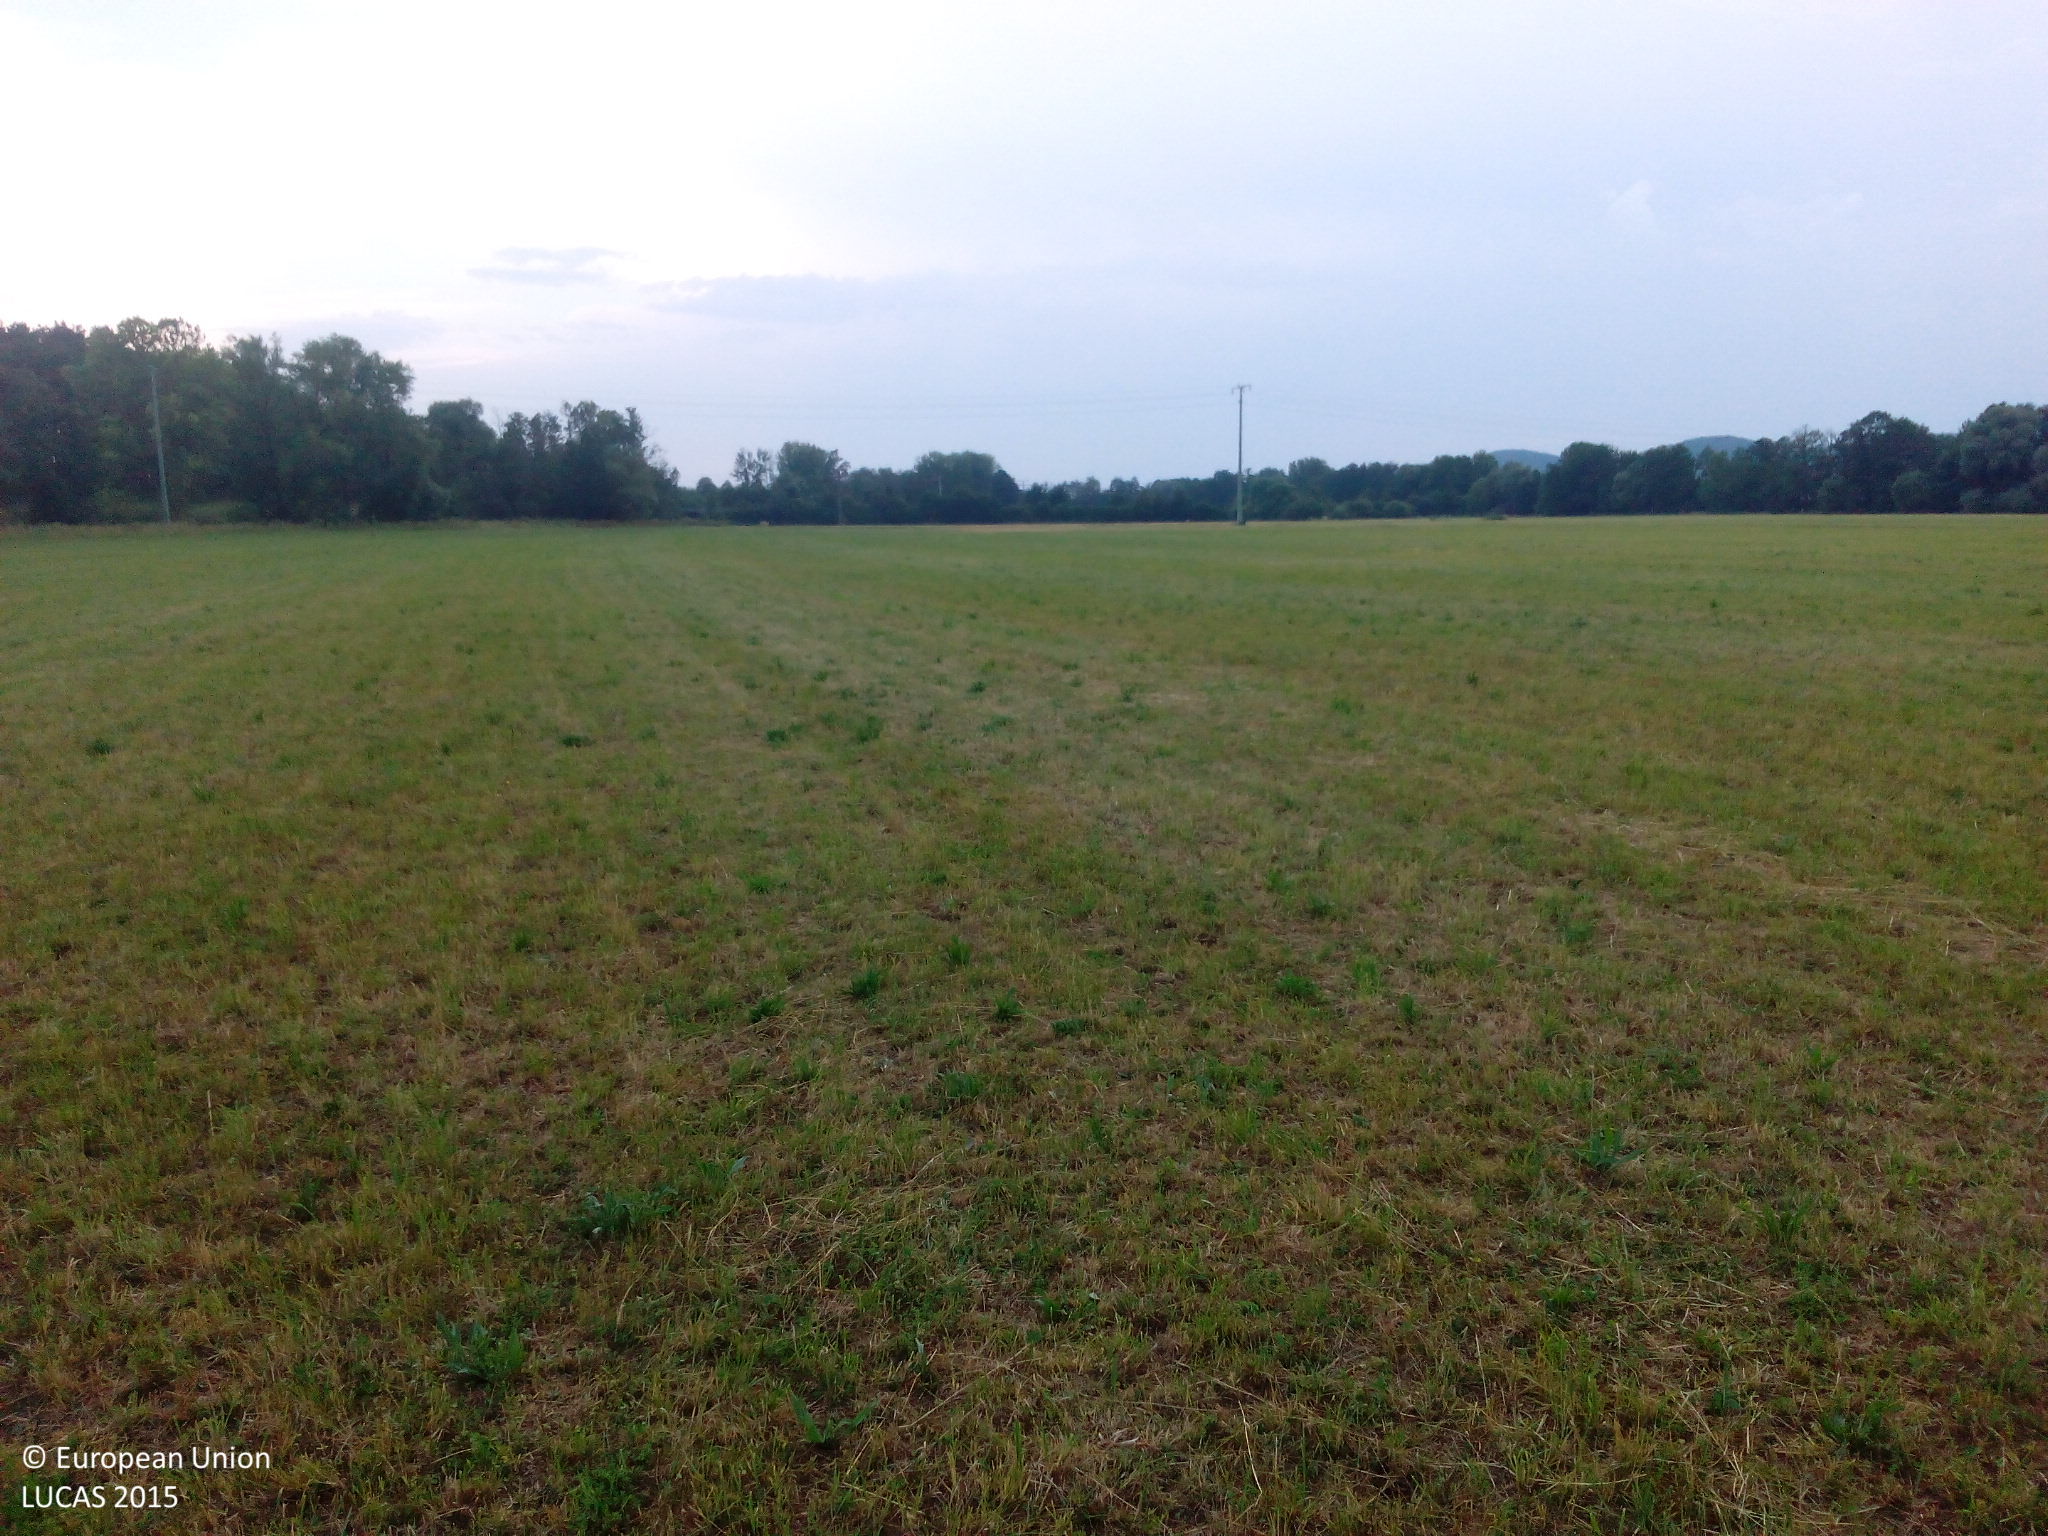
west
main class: Grassland
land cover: Grassland without tree/shrub cover
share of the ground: > 75 %
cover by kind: herbaceous plants 100 %
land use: Agriculture (excluding fallow land and kitchen gardens)
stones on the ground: < 10 %
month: July
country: DE
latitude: 49.9289
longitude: 10.9052
